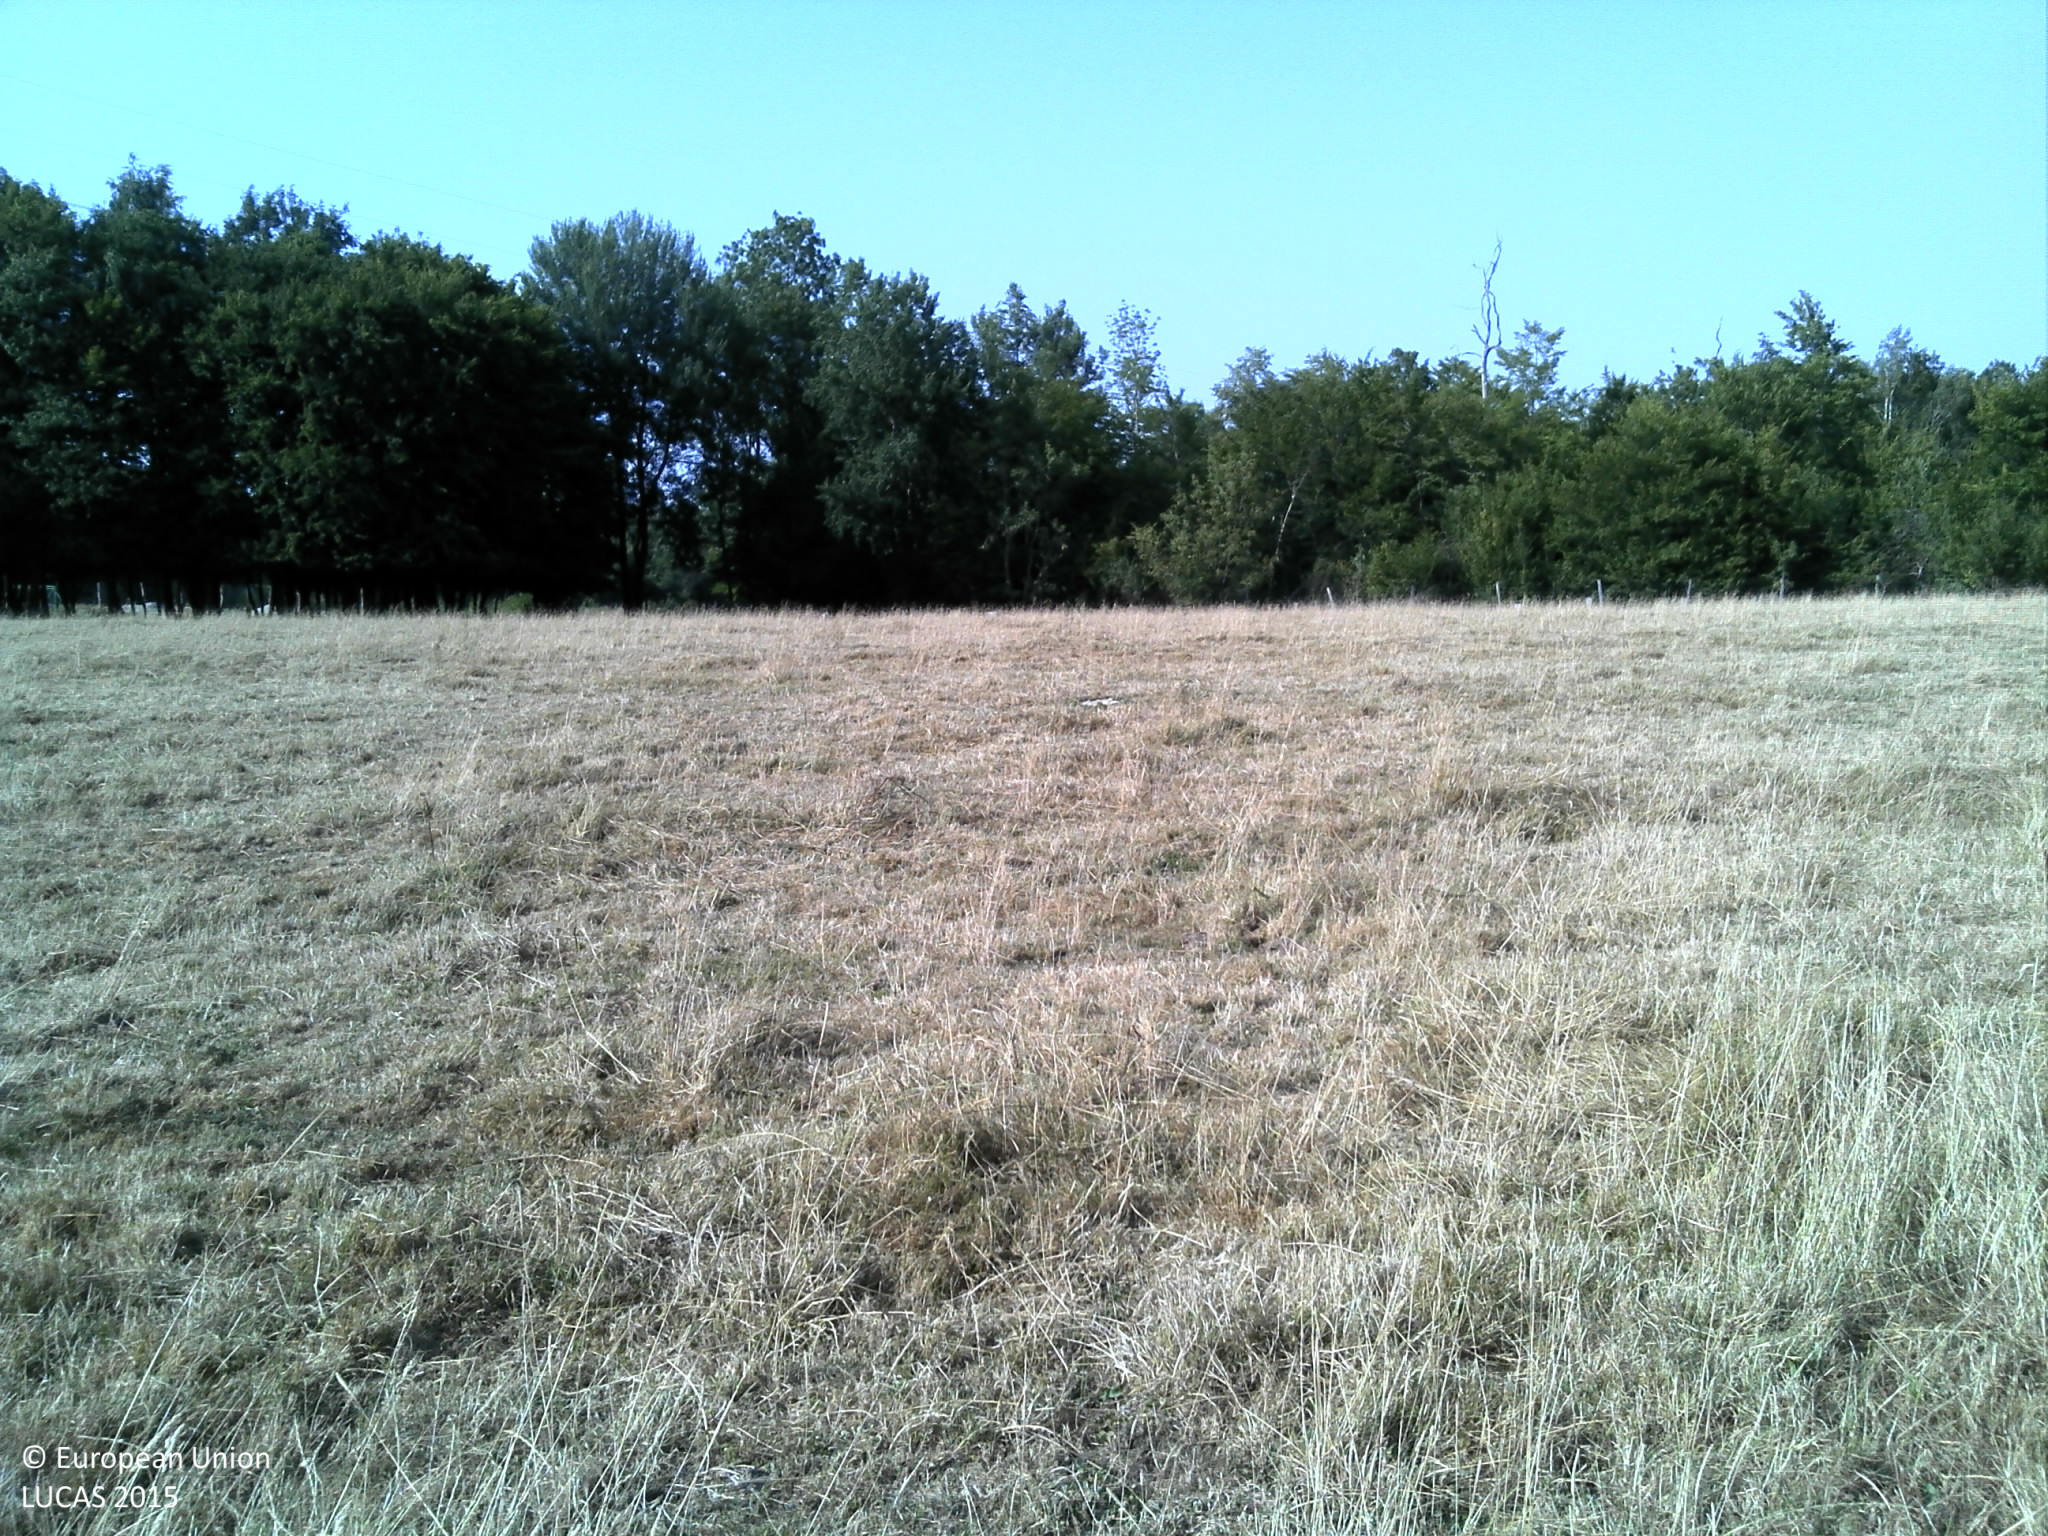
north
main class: Grassland
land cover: Grassland without tree/shrub cover
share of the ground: > 75 %
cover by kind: herbaceous plants 100 %
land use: Agriculture (excluding fallow land and kitchen gardens)
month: July
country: FR
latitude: 48.7532
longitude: 4.8700
